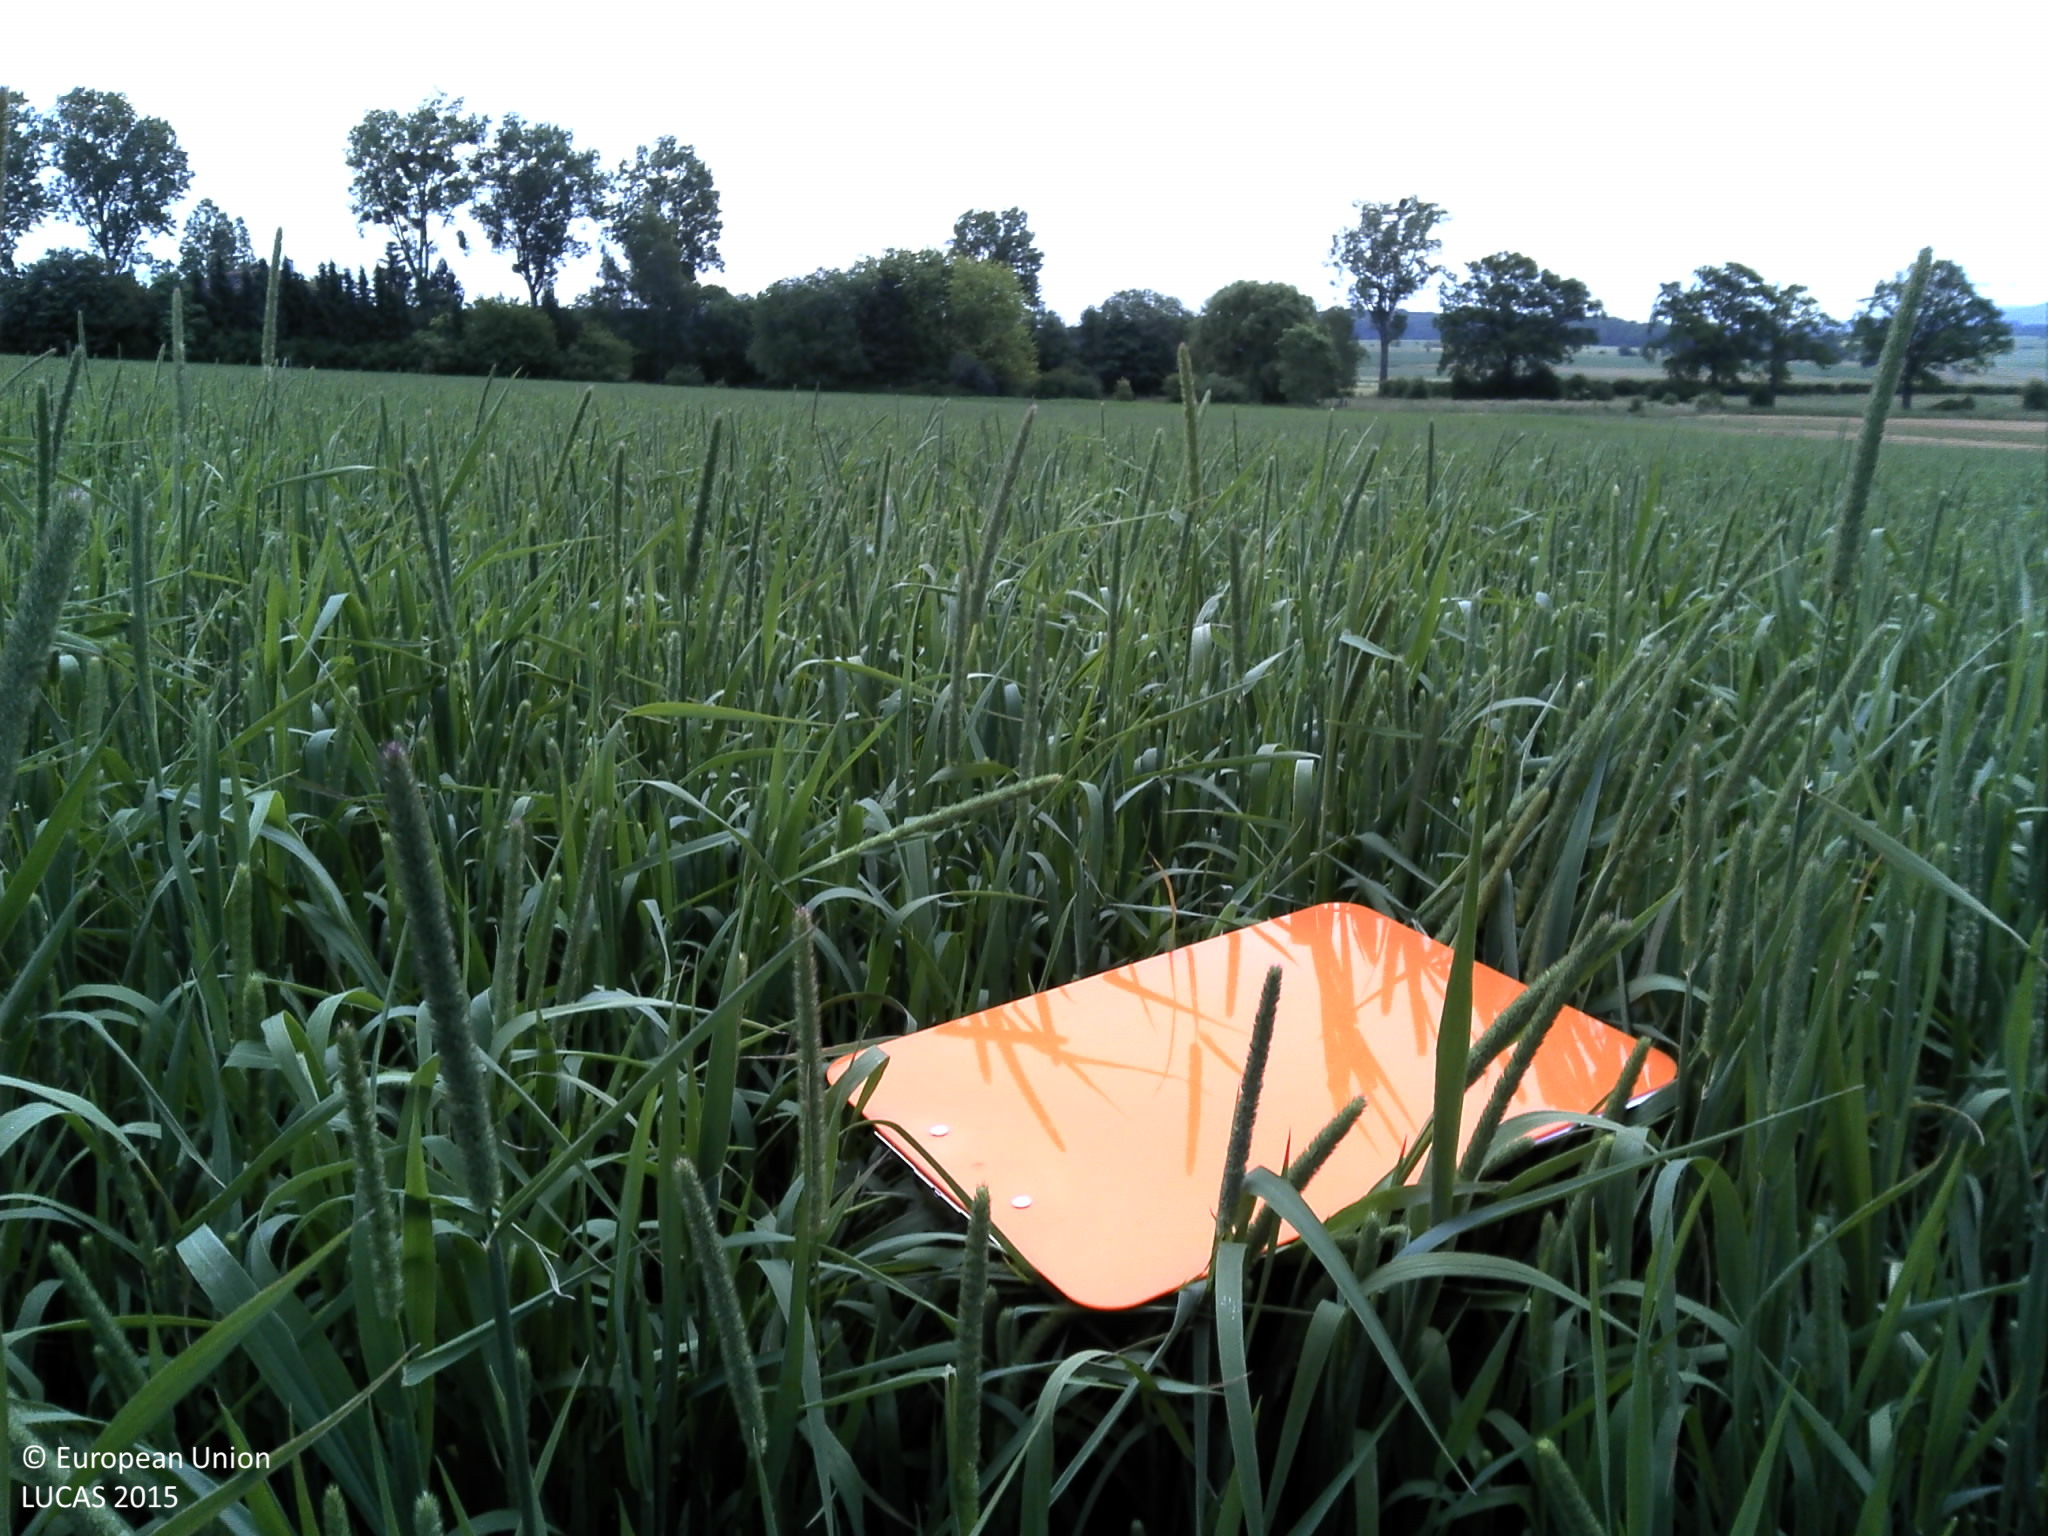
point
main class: Cropland
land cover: Temporary grasslands
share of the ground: > 75 %
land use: Agriculture (excluding fallow land and kitchen gardens)
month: June
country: LU
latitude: 49.5551
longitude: 5.9766
